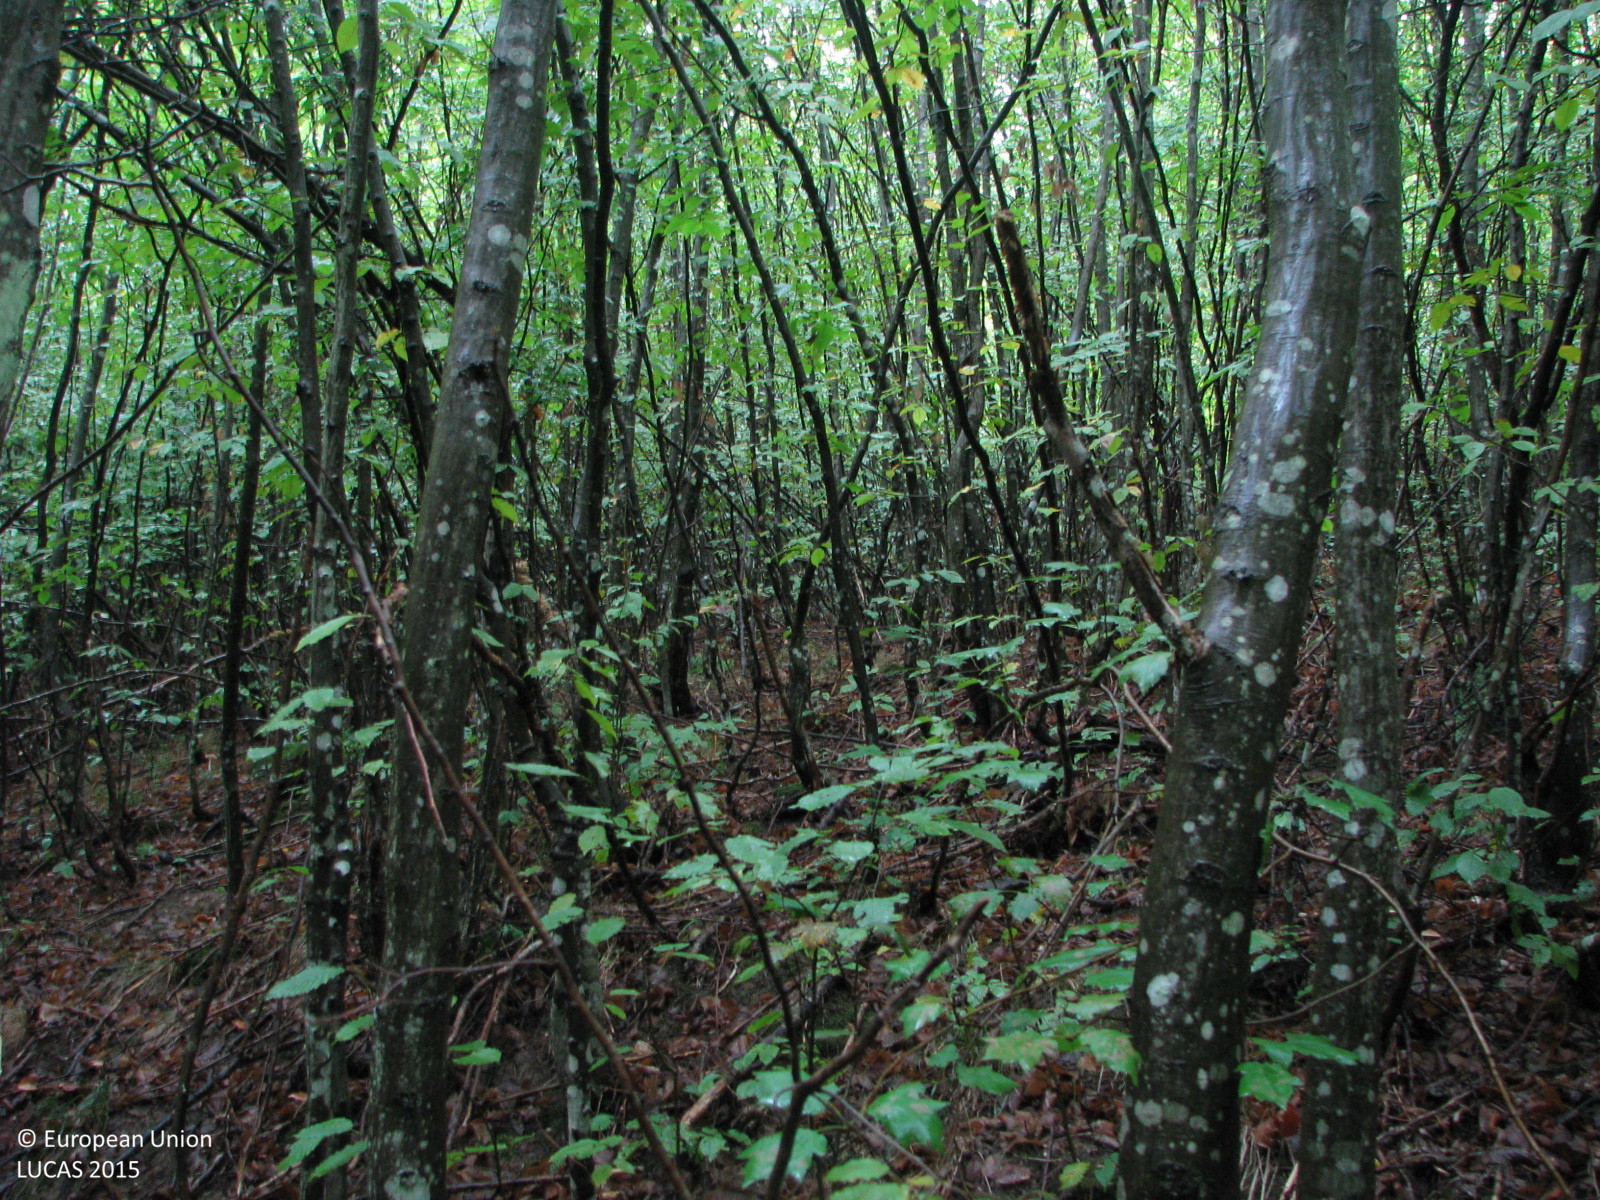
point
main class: Woodland
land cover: Broadleaved woodland
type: mesophytic deciduous forest
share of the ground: > 75 %
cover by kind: broadleaved forest trees 100 %
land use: Forestry
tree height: > 5 m
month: September
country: BG
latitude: 42.9282
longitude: 26.3784
